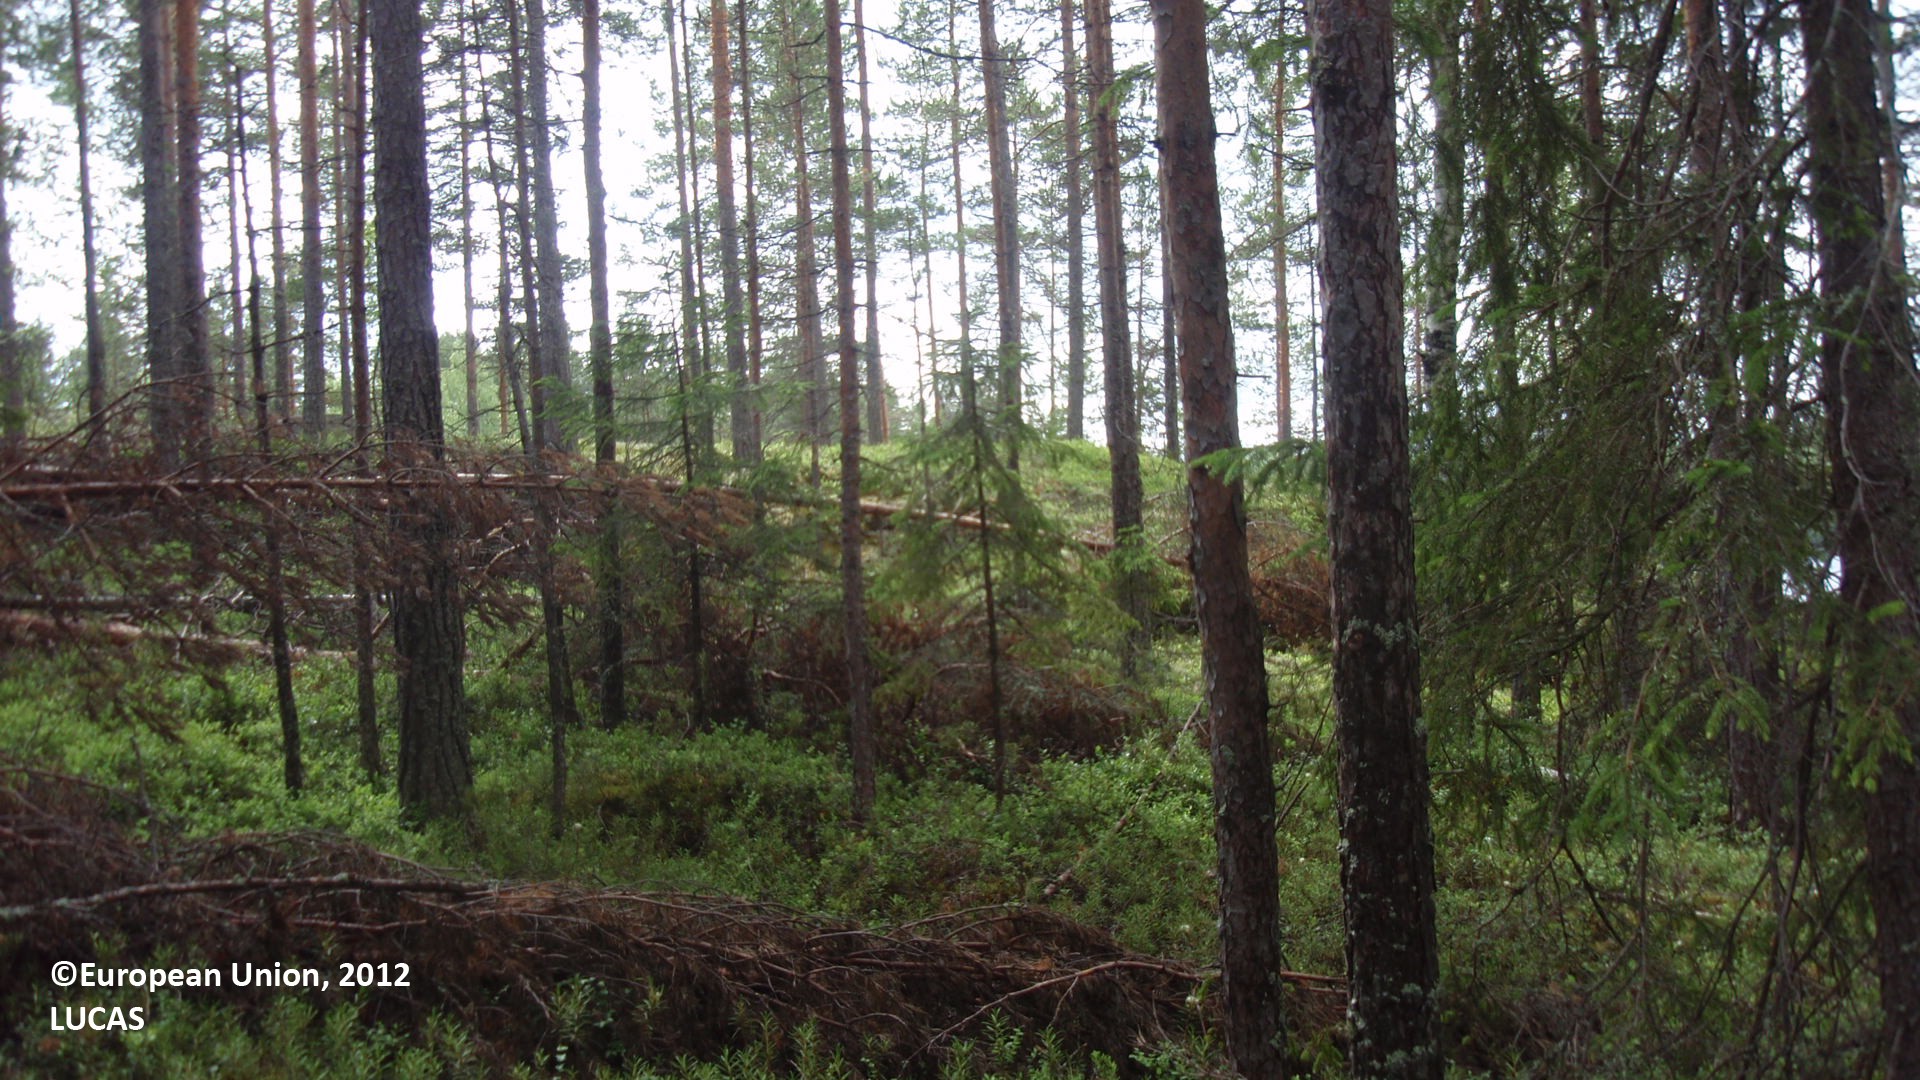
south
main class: Woodland
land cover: Pine dominated mixed woodland
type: boreal forest
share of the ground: 50 - 75 %
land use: Forestry
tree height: > 5 m
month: July
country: FI
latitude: 61.6277
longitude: 28.8422
